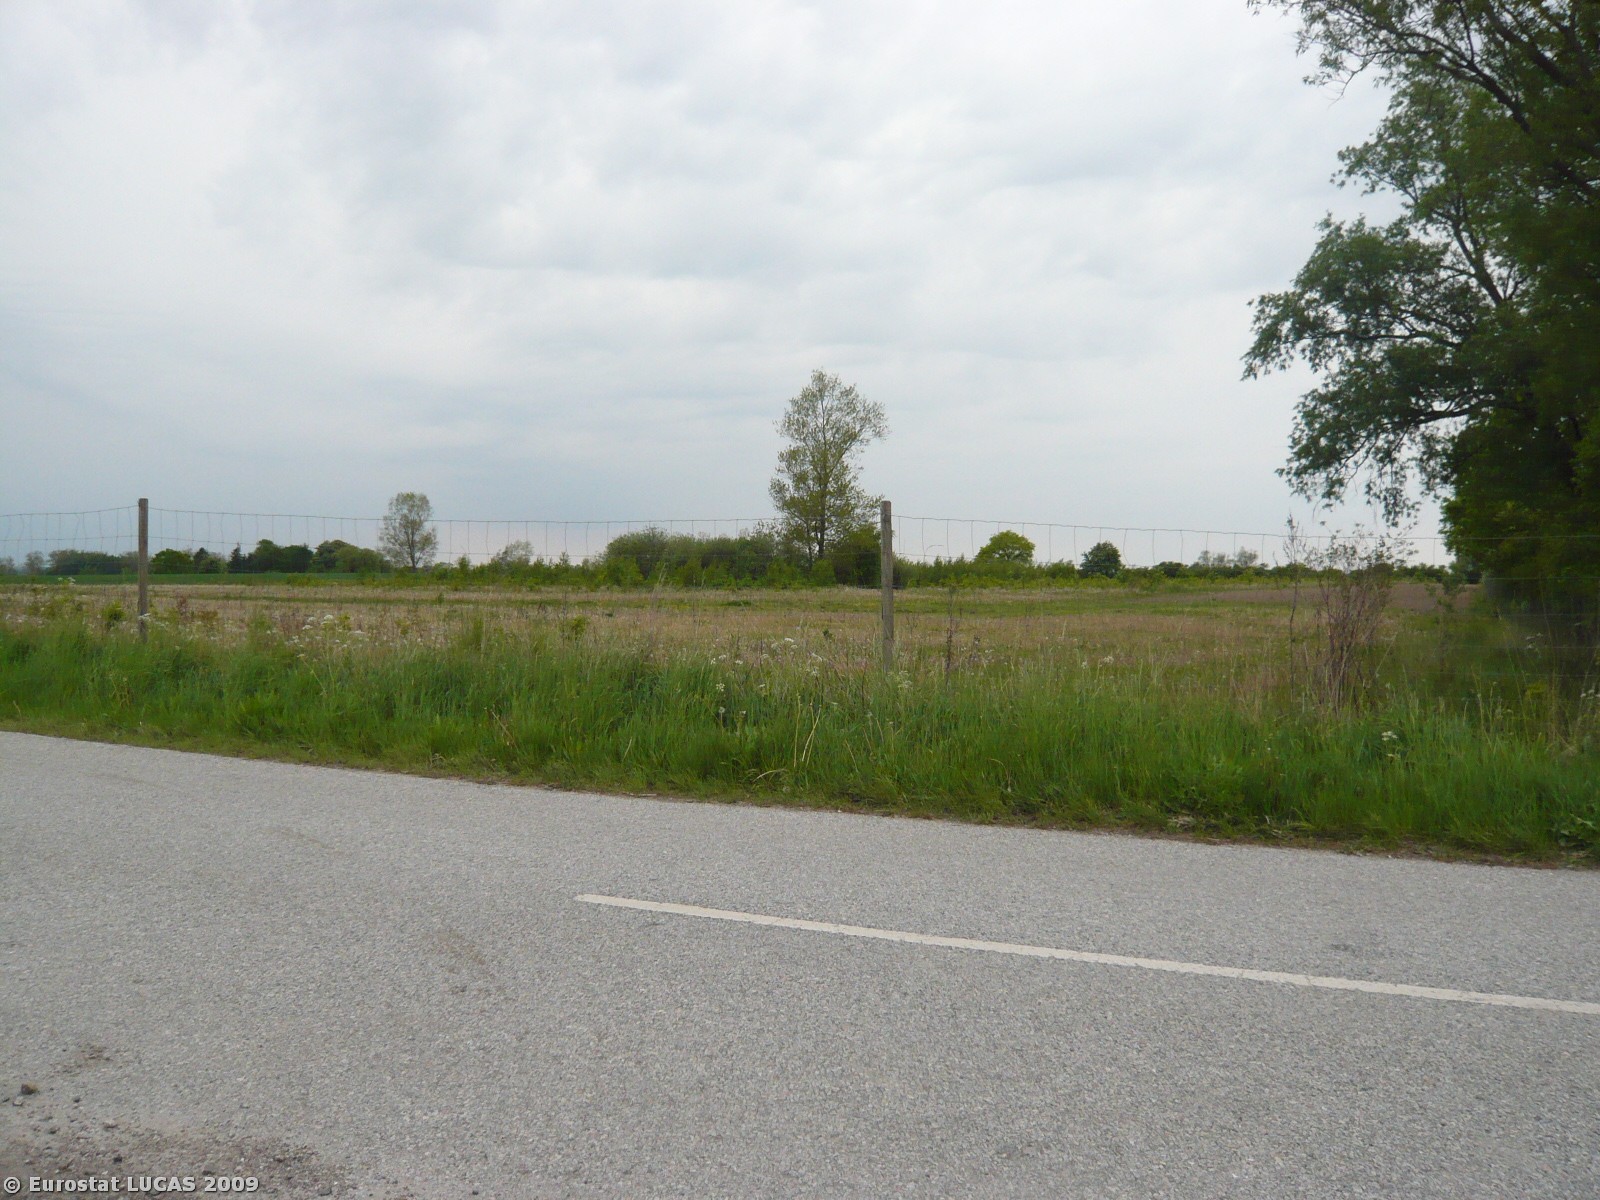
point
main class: Shrubland
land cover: Shrubland with sparse tree cover
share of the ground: 25 - 50 %
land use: Agriculture (excluding fallow land and kitchen gardens)
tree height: > 5 m
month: May
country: DK
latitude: 55.3999
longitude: 11.9407
